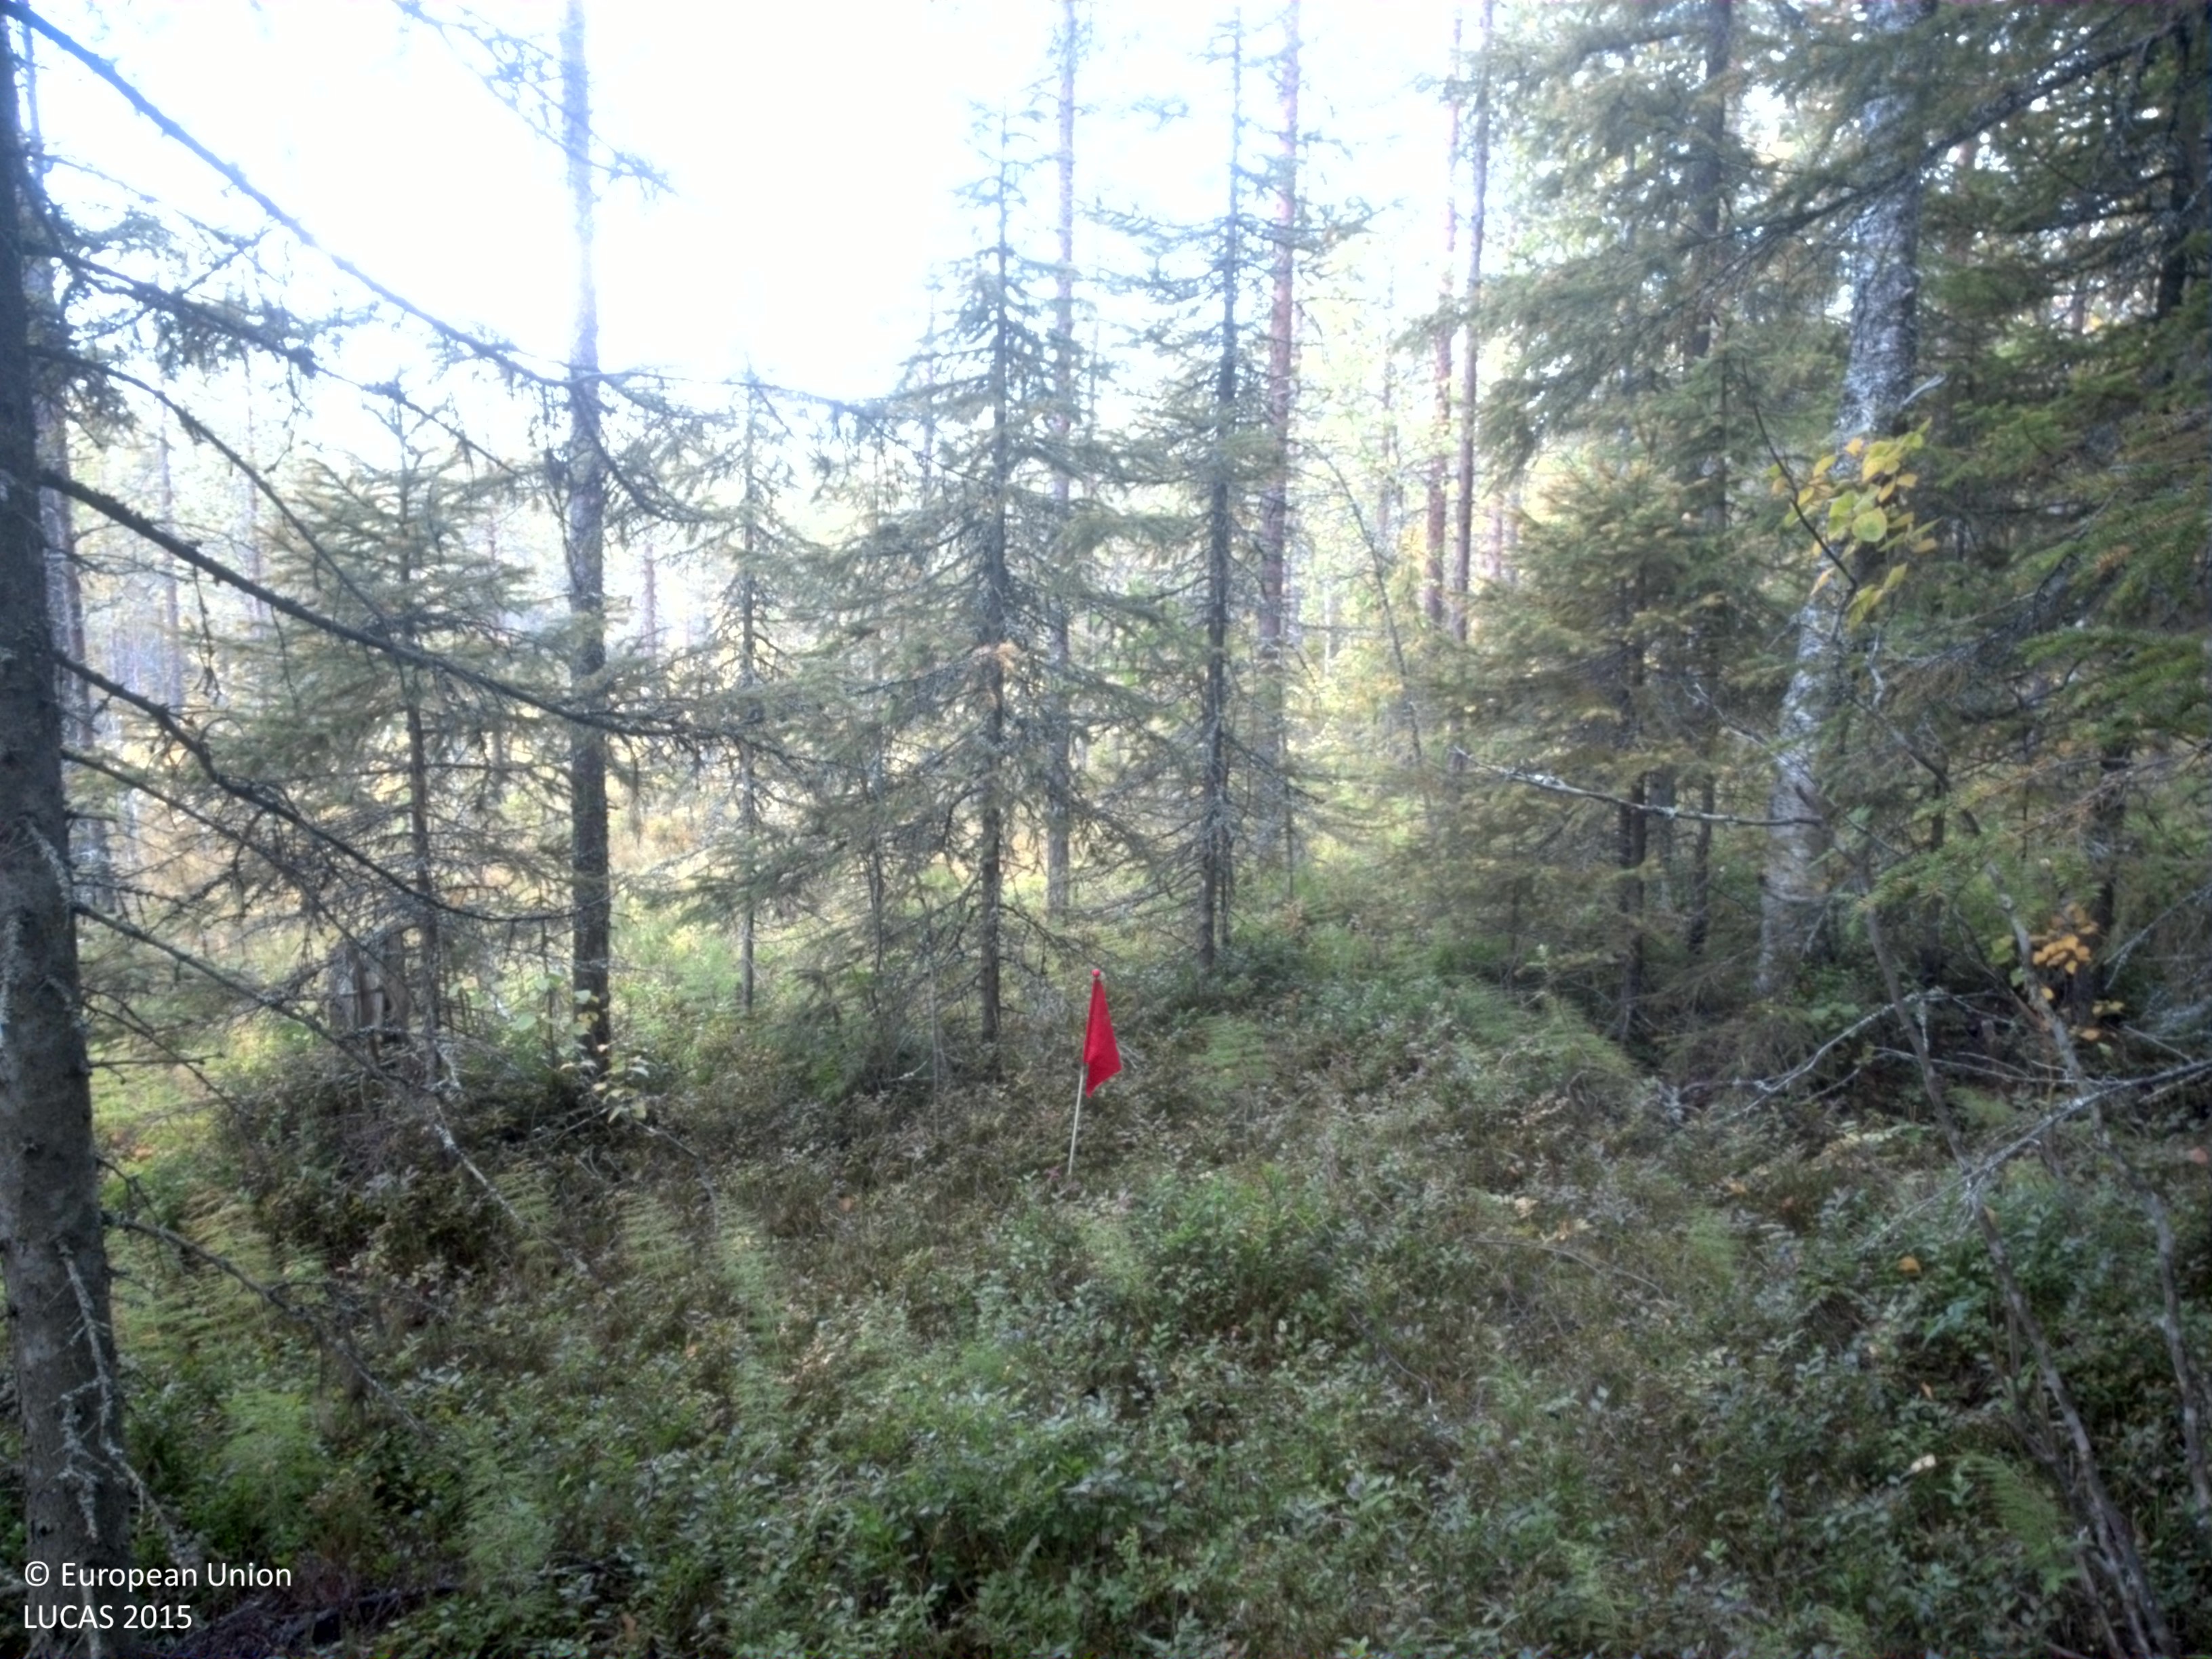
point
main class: Woodland
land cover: Spruce dominated mixed woodland
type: boreal forest
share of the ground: 50 - 75 %
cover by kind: coniferous forest trees 45 %, shrubs 35 %, broadleaved forest trees 15 %, lichens and mosses 5 %
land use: Forestry
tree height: > 5 m
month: September
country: SE
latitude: 64.4790
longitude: 19.7710
